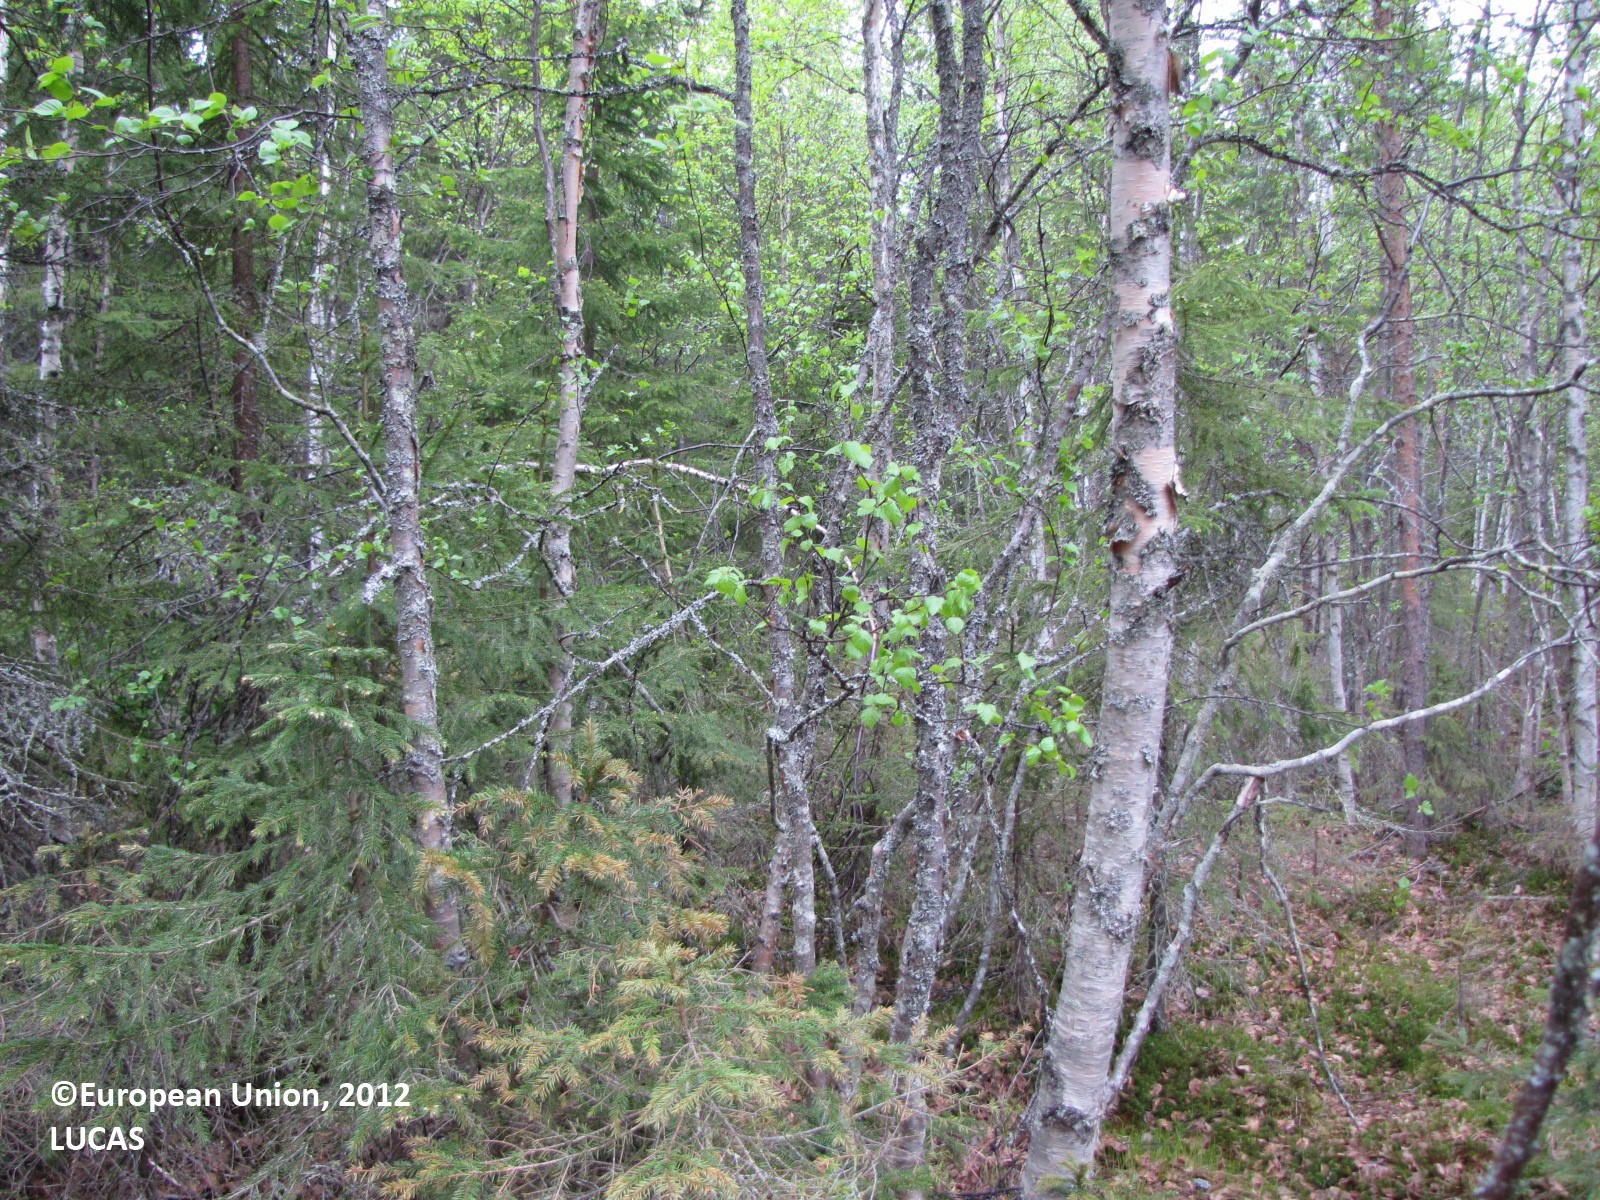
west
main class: Woodland
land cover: Other mixed woodland
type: boreal forest
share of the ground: 50 - 75 %
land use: Forestry
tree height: > 5 m
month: June
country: FI
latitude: 65.9015
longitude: 24.7405
